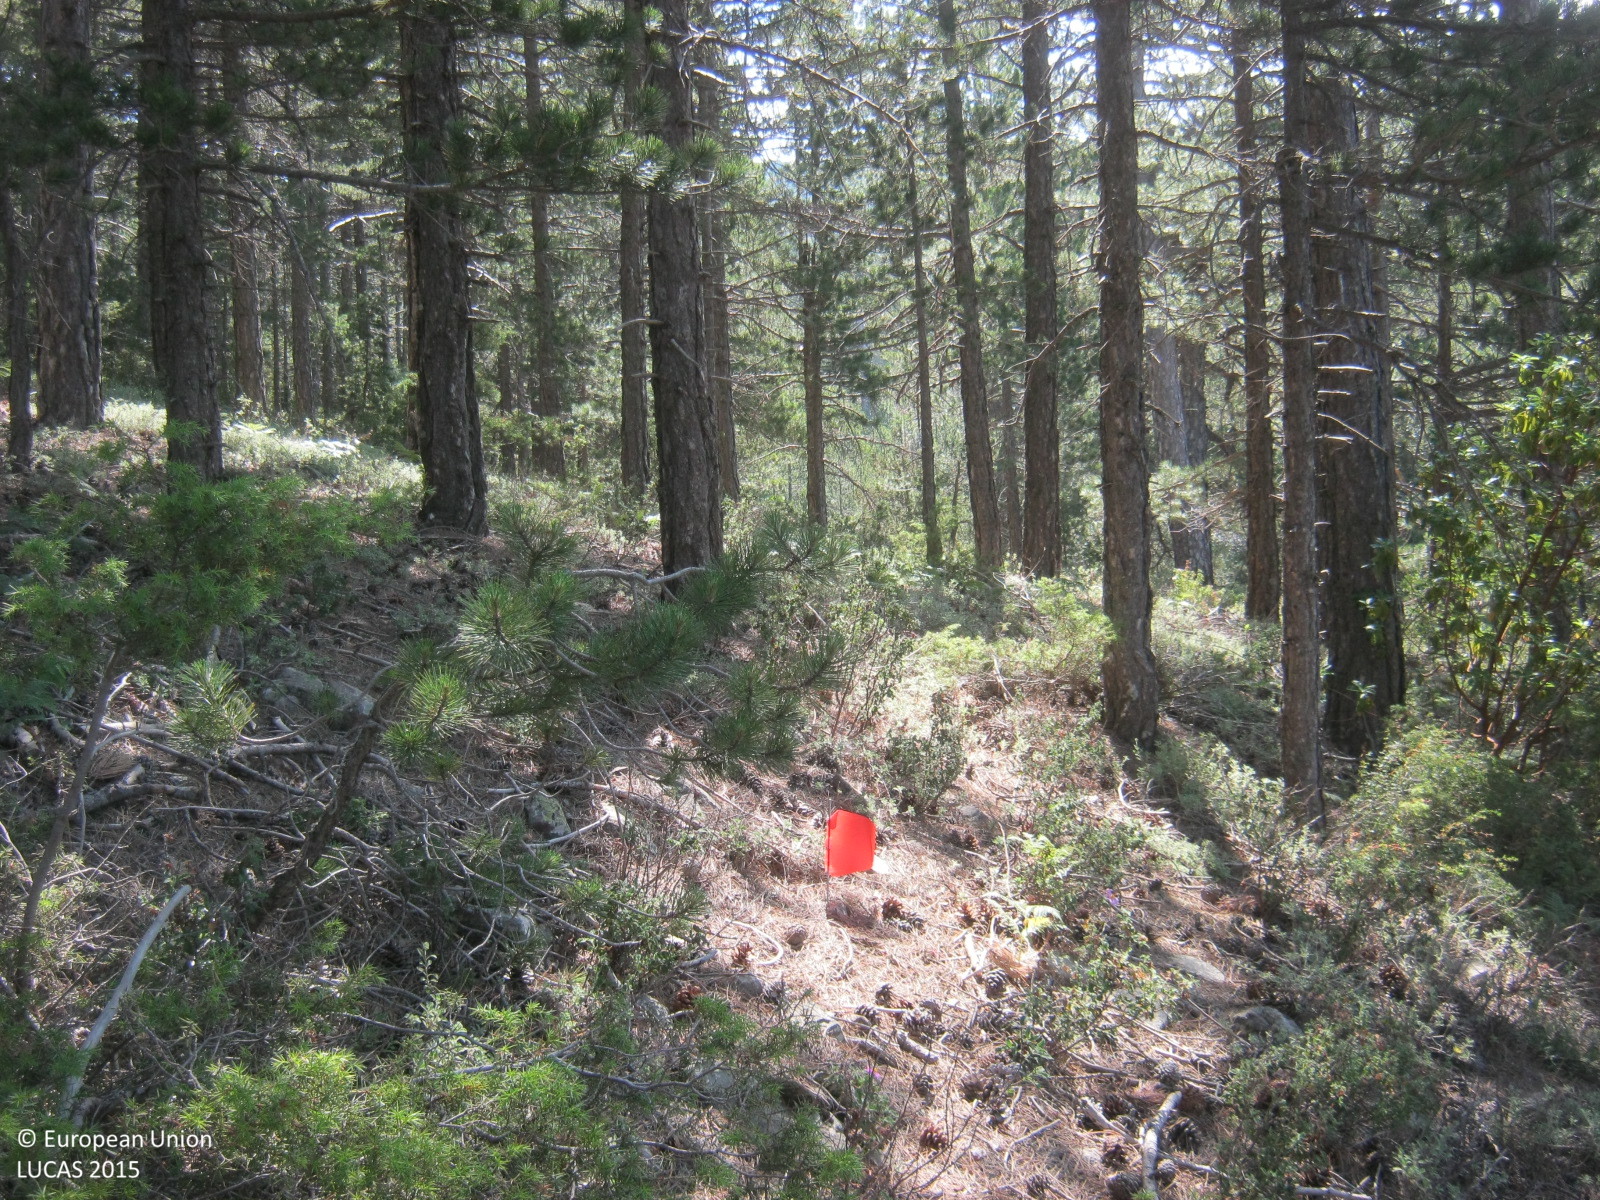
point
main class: Woodland
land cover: Pine dominated coniferous woodland
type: coniferous forest of the mediterranean region
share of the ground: > 75 %
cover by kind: coniferous forest trees 80 %, shrubs 10 %, broadleaved forest trees 5 %, unconsolidated bare surface 5 %
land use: Forestry
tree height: > 5 m
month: June
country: CY
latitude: 34.9465
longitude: 32.8427
